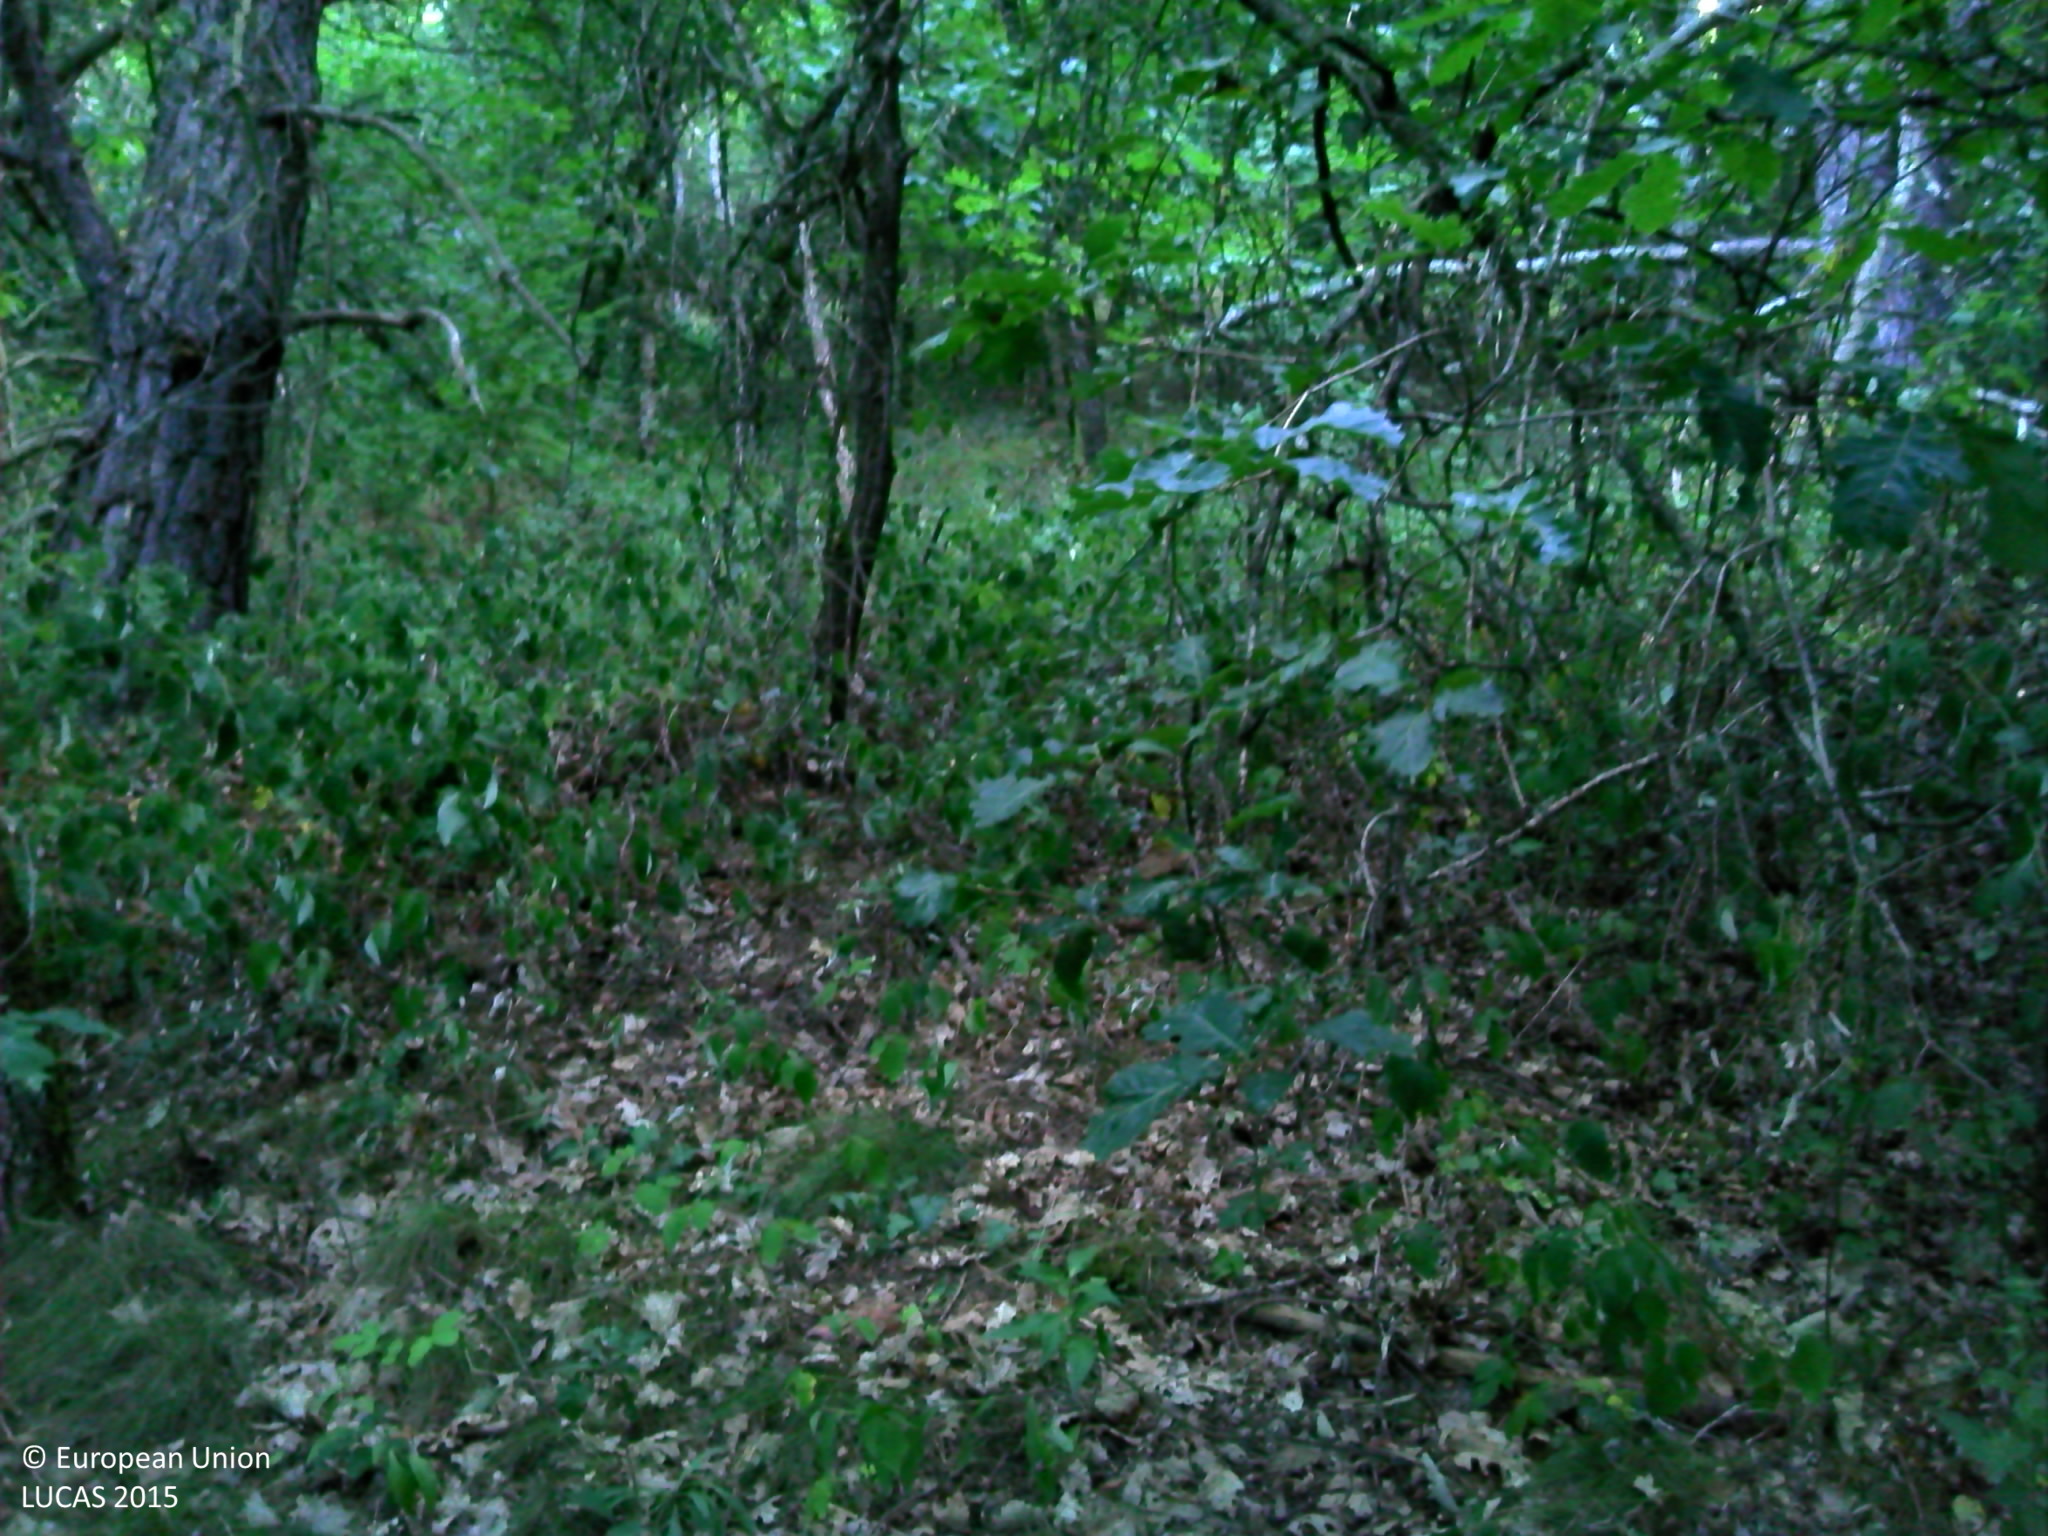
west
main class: Woodland
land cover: Spruce dominated mixed woodland
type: acidophilous oak and oak-birch forest
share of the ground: > 75 %
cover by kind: coniferous forest trees 75 %, broadleaved forest trees 25 %
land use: Forestry
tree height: > 5 m
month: July
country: FR
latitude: 45.1221
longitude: 3.4813
